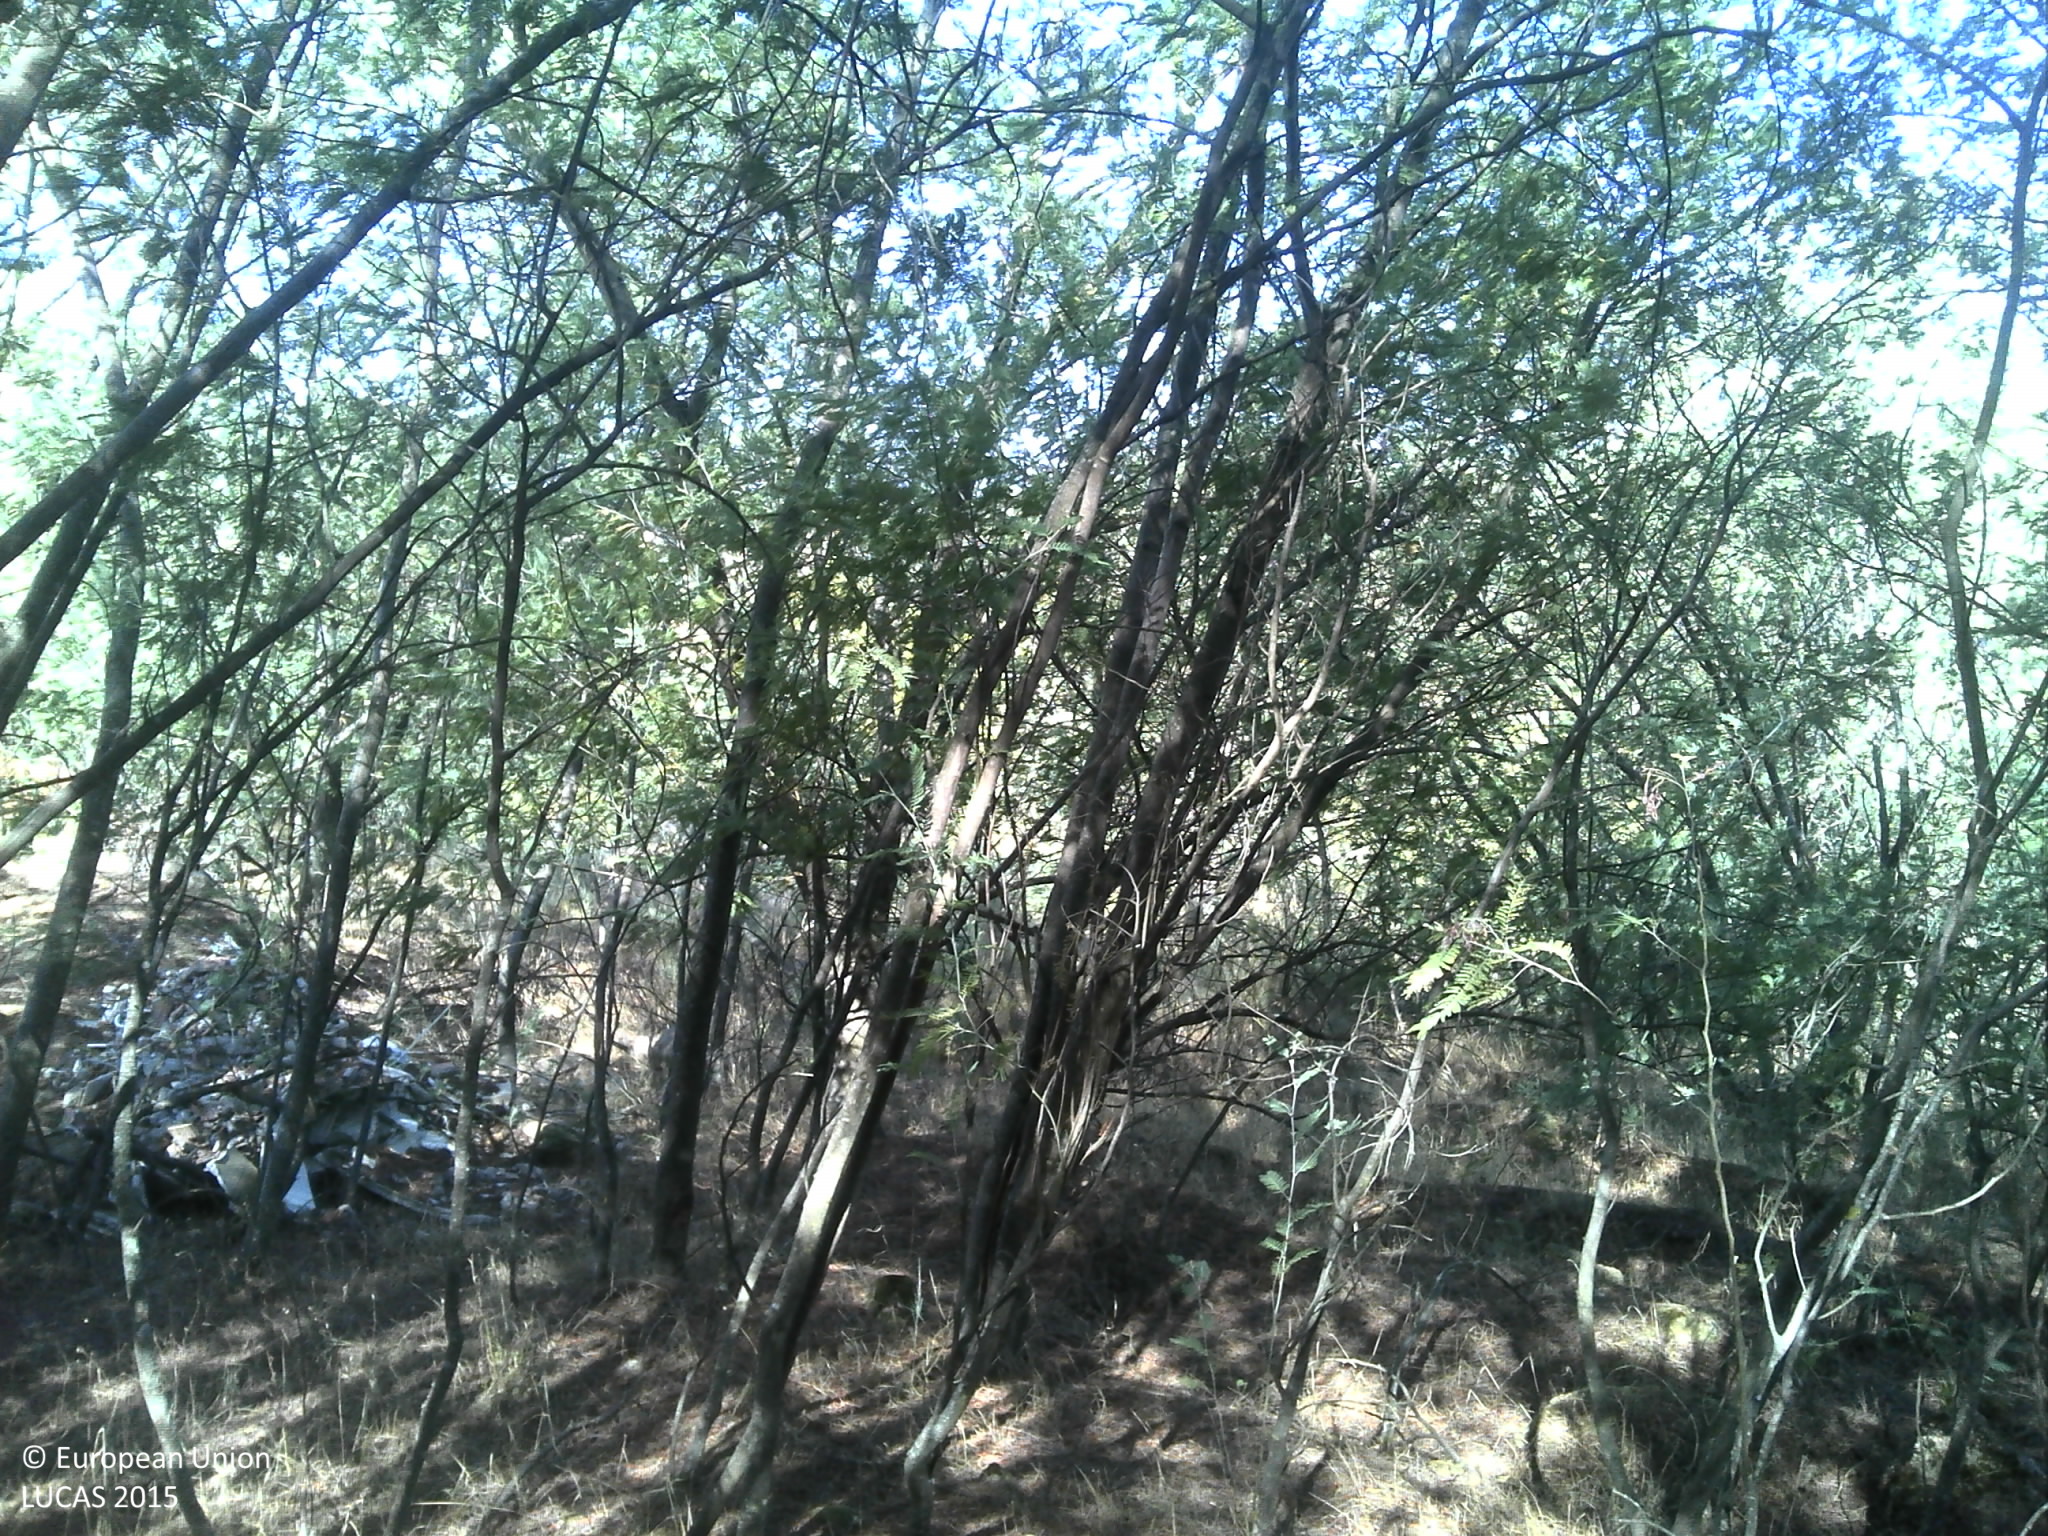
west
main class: Woodland
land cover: Broadleaved woodland
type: exotic forest
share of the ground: 50 - 75 %
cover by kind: broadleaved forest trees 60 %, shrubs 20 %, unconsolidated bare surface 10 %, herbaceous plants 5 %
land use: Forestry
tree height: > 5 m
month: July
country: PT
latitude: 40.3931
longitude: -7.3168
